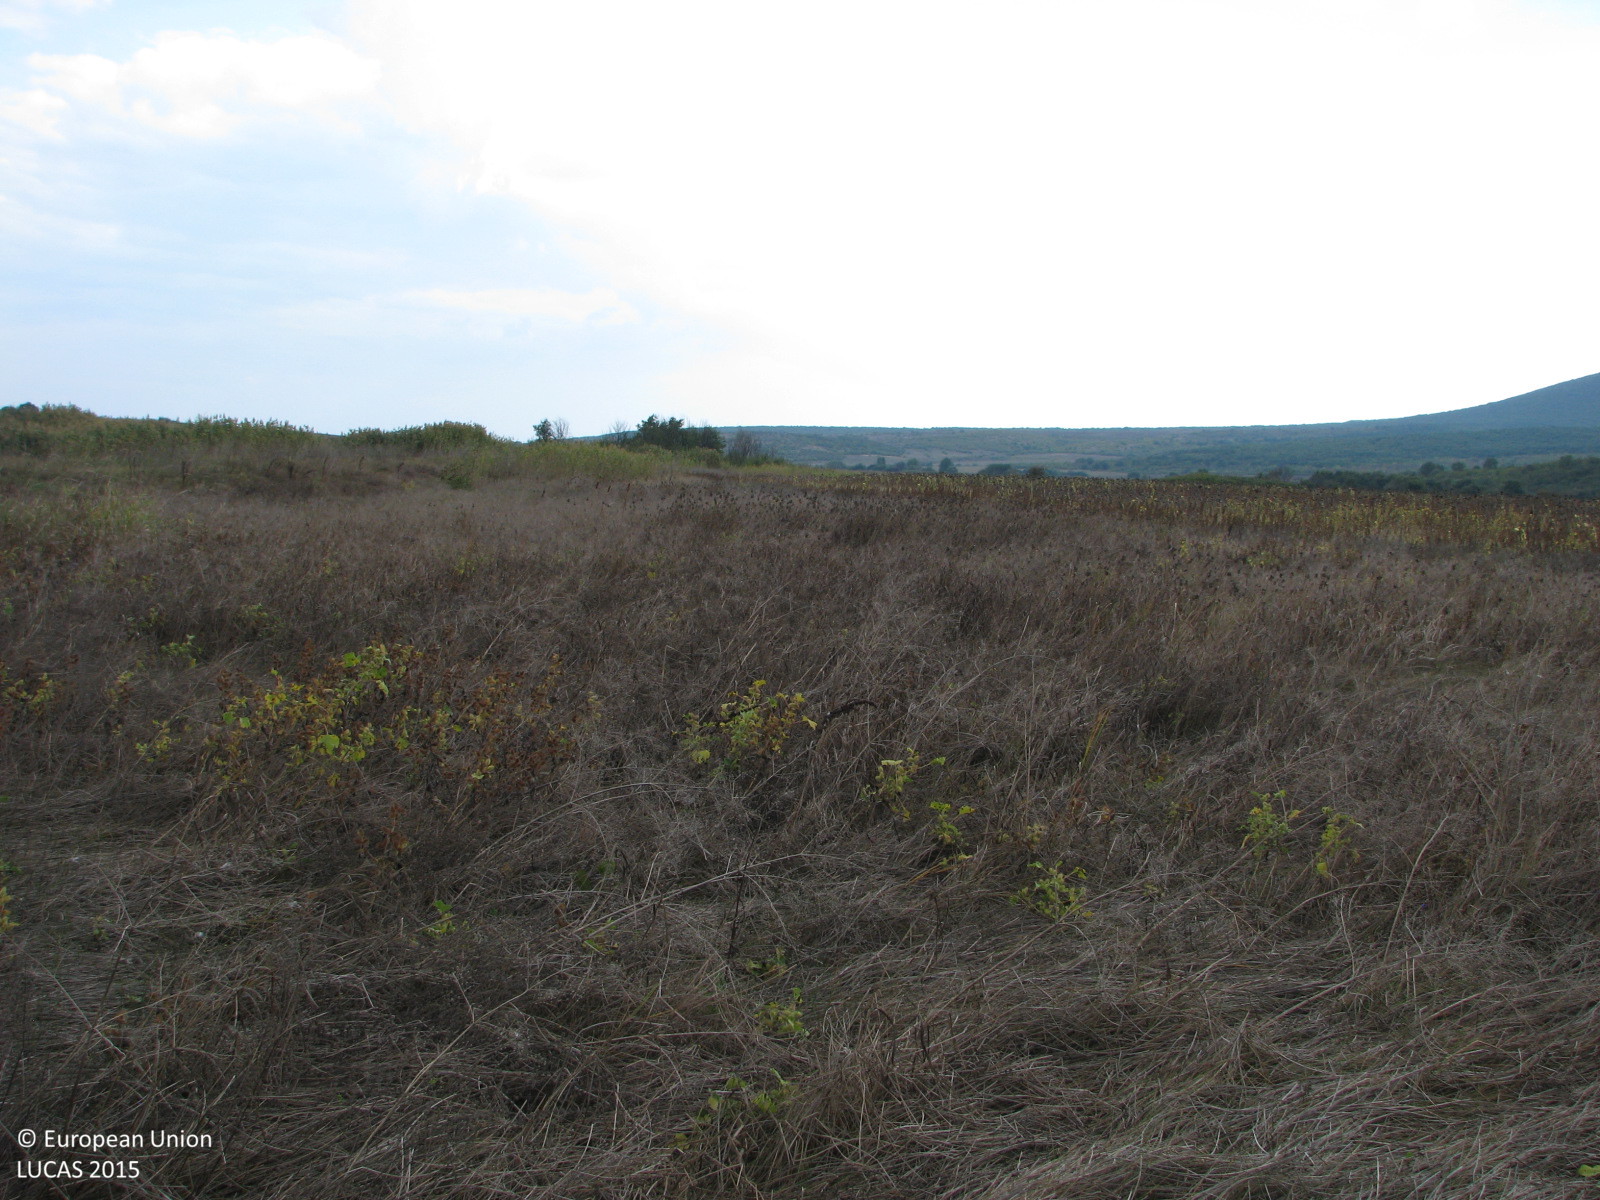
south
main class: Grassland
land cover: Spontaneously vegetated surfaces
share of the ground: > 75 %
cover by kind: herbaceous plants 100 %
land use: Fallow land
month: October
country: BG
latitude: 42.2602
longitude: 26.4160
